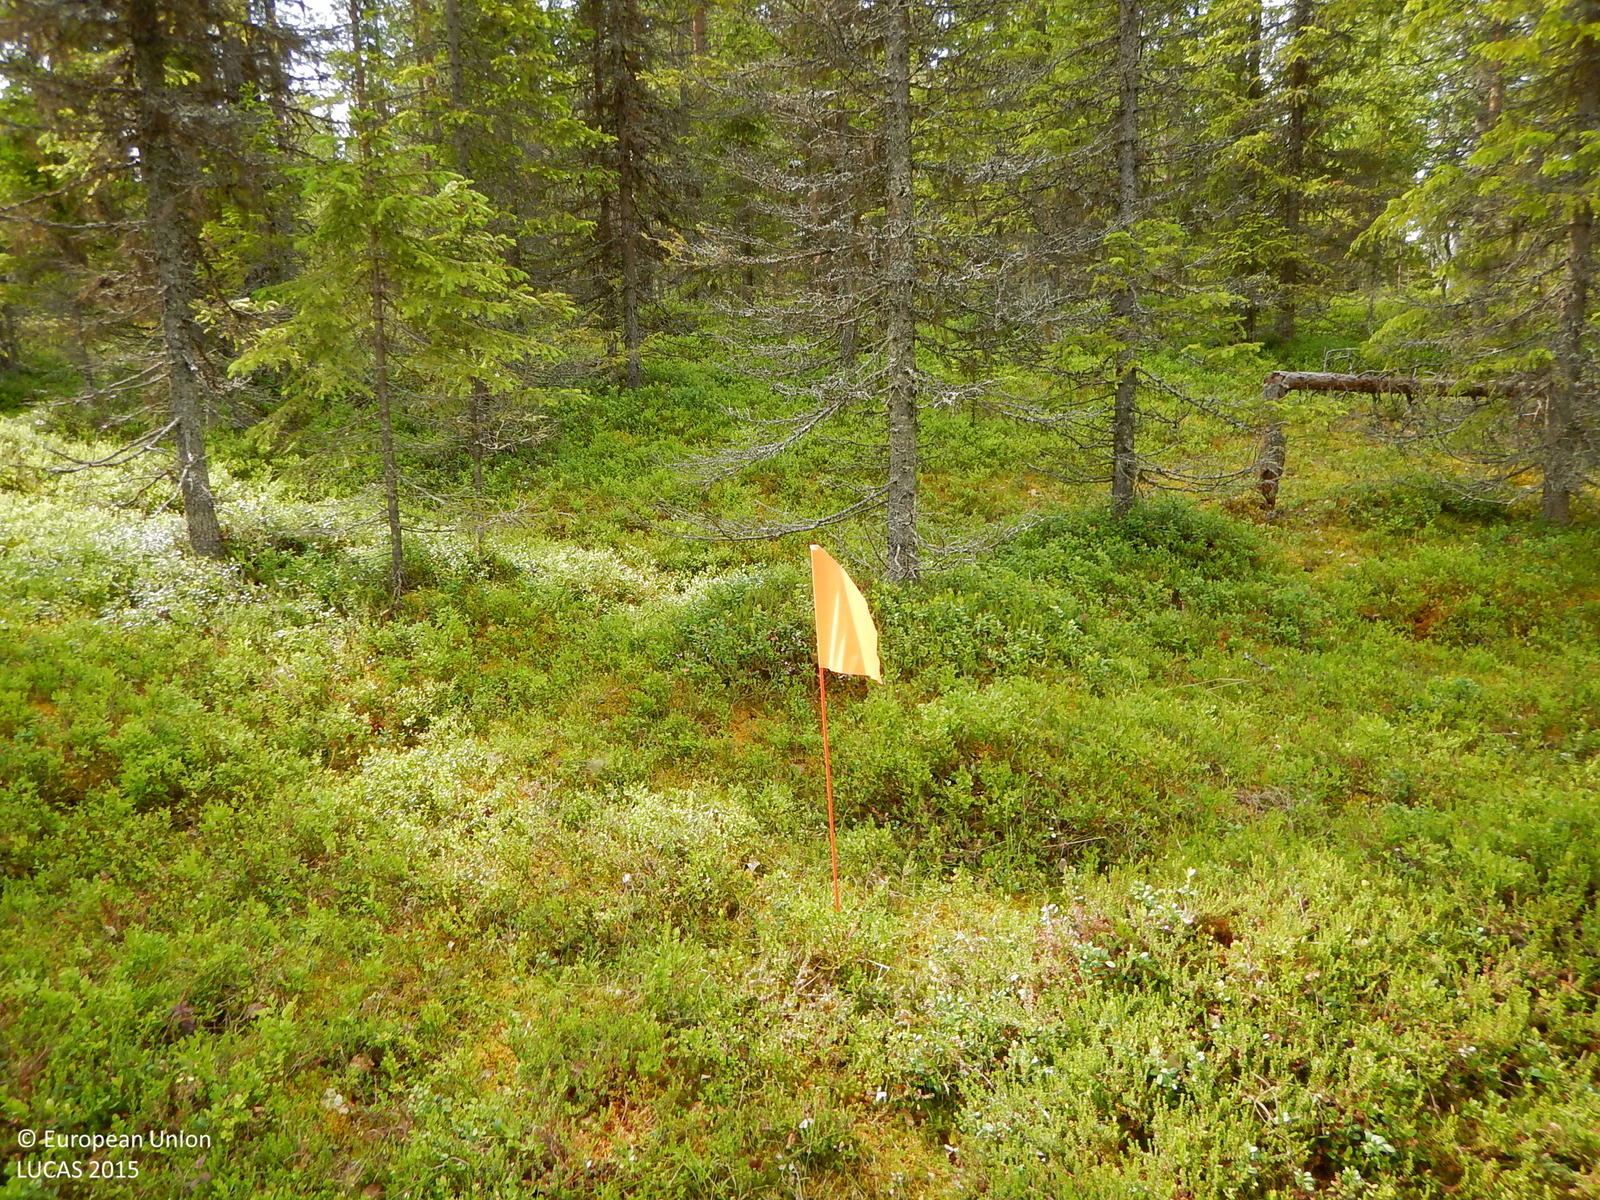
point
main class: Woodland
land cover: Spruce dominated coniferous woodland
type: boreal forest
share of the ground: 25 - 50 %
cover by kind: shrubs 40 %, coniferous forest trees 30 %, broadleaved forest trees 10 %, herbaceous plants 10 %, lichens and mosses 10 %
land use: Forestry
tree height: > 5 m
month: July
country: SE
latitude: 65.2361
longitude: 18.9708
